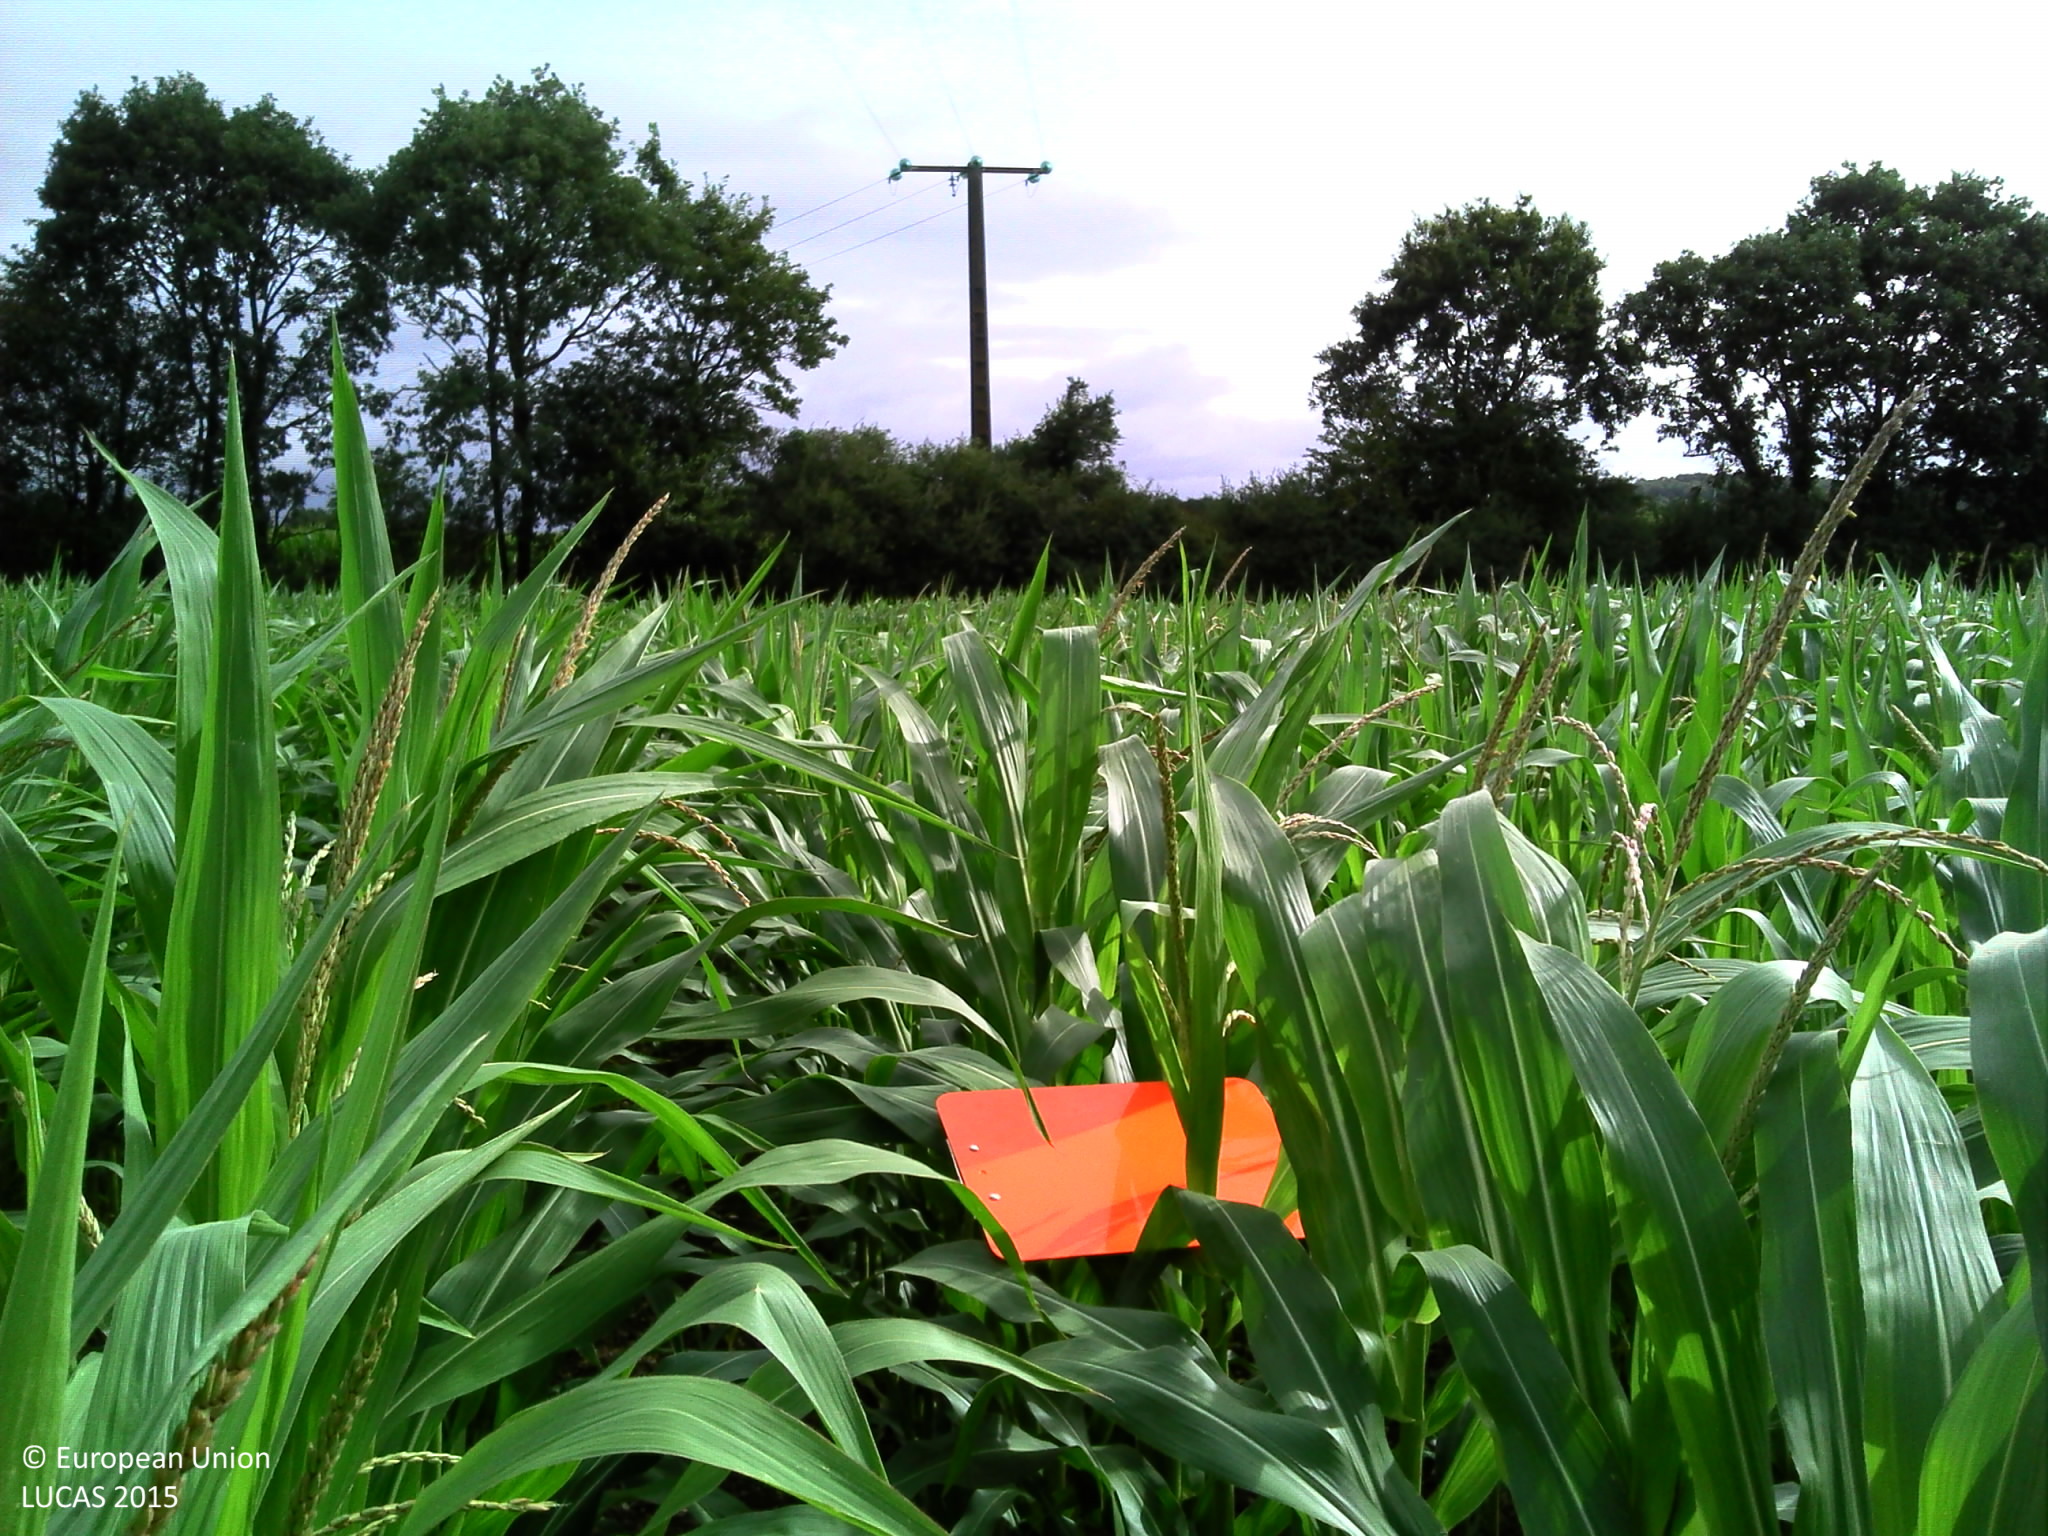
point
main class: Cropland
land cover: Maize
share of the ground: 50 - 75 %
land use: Agriculture (excluding fallow land and kitchen gardens)
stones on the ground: 10 - 25 %
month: July
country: FR
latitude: 47.4557
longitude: -1.8389
